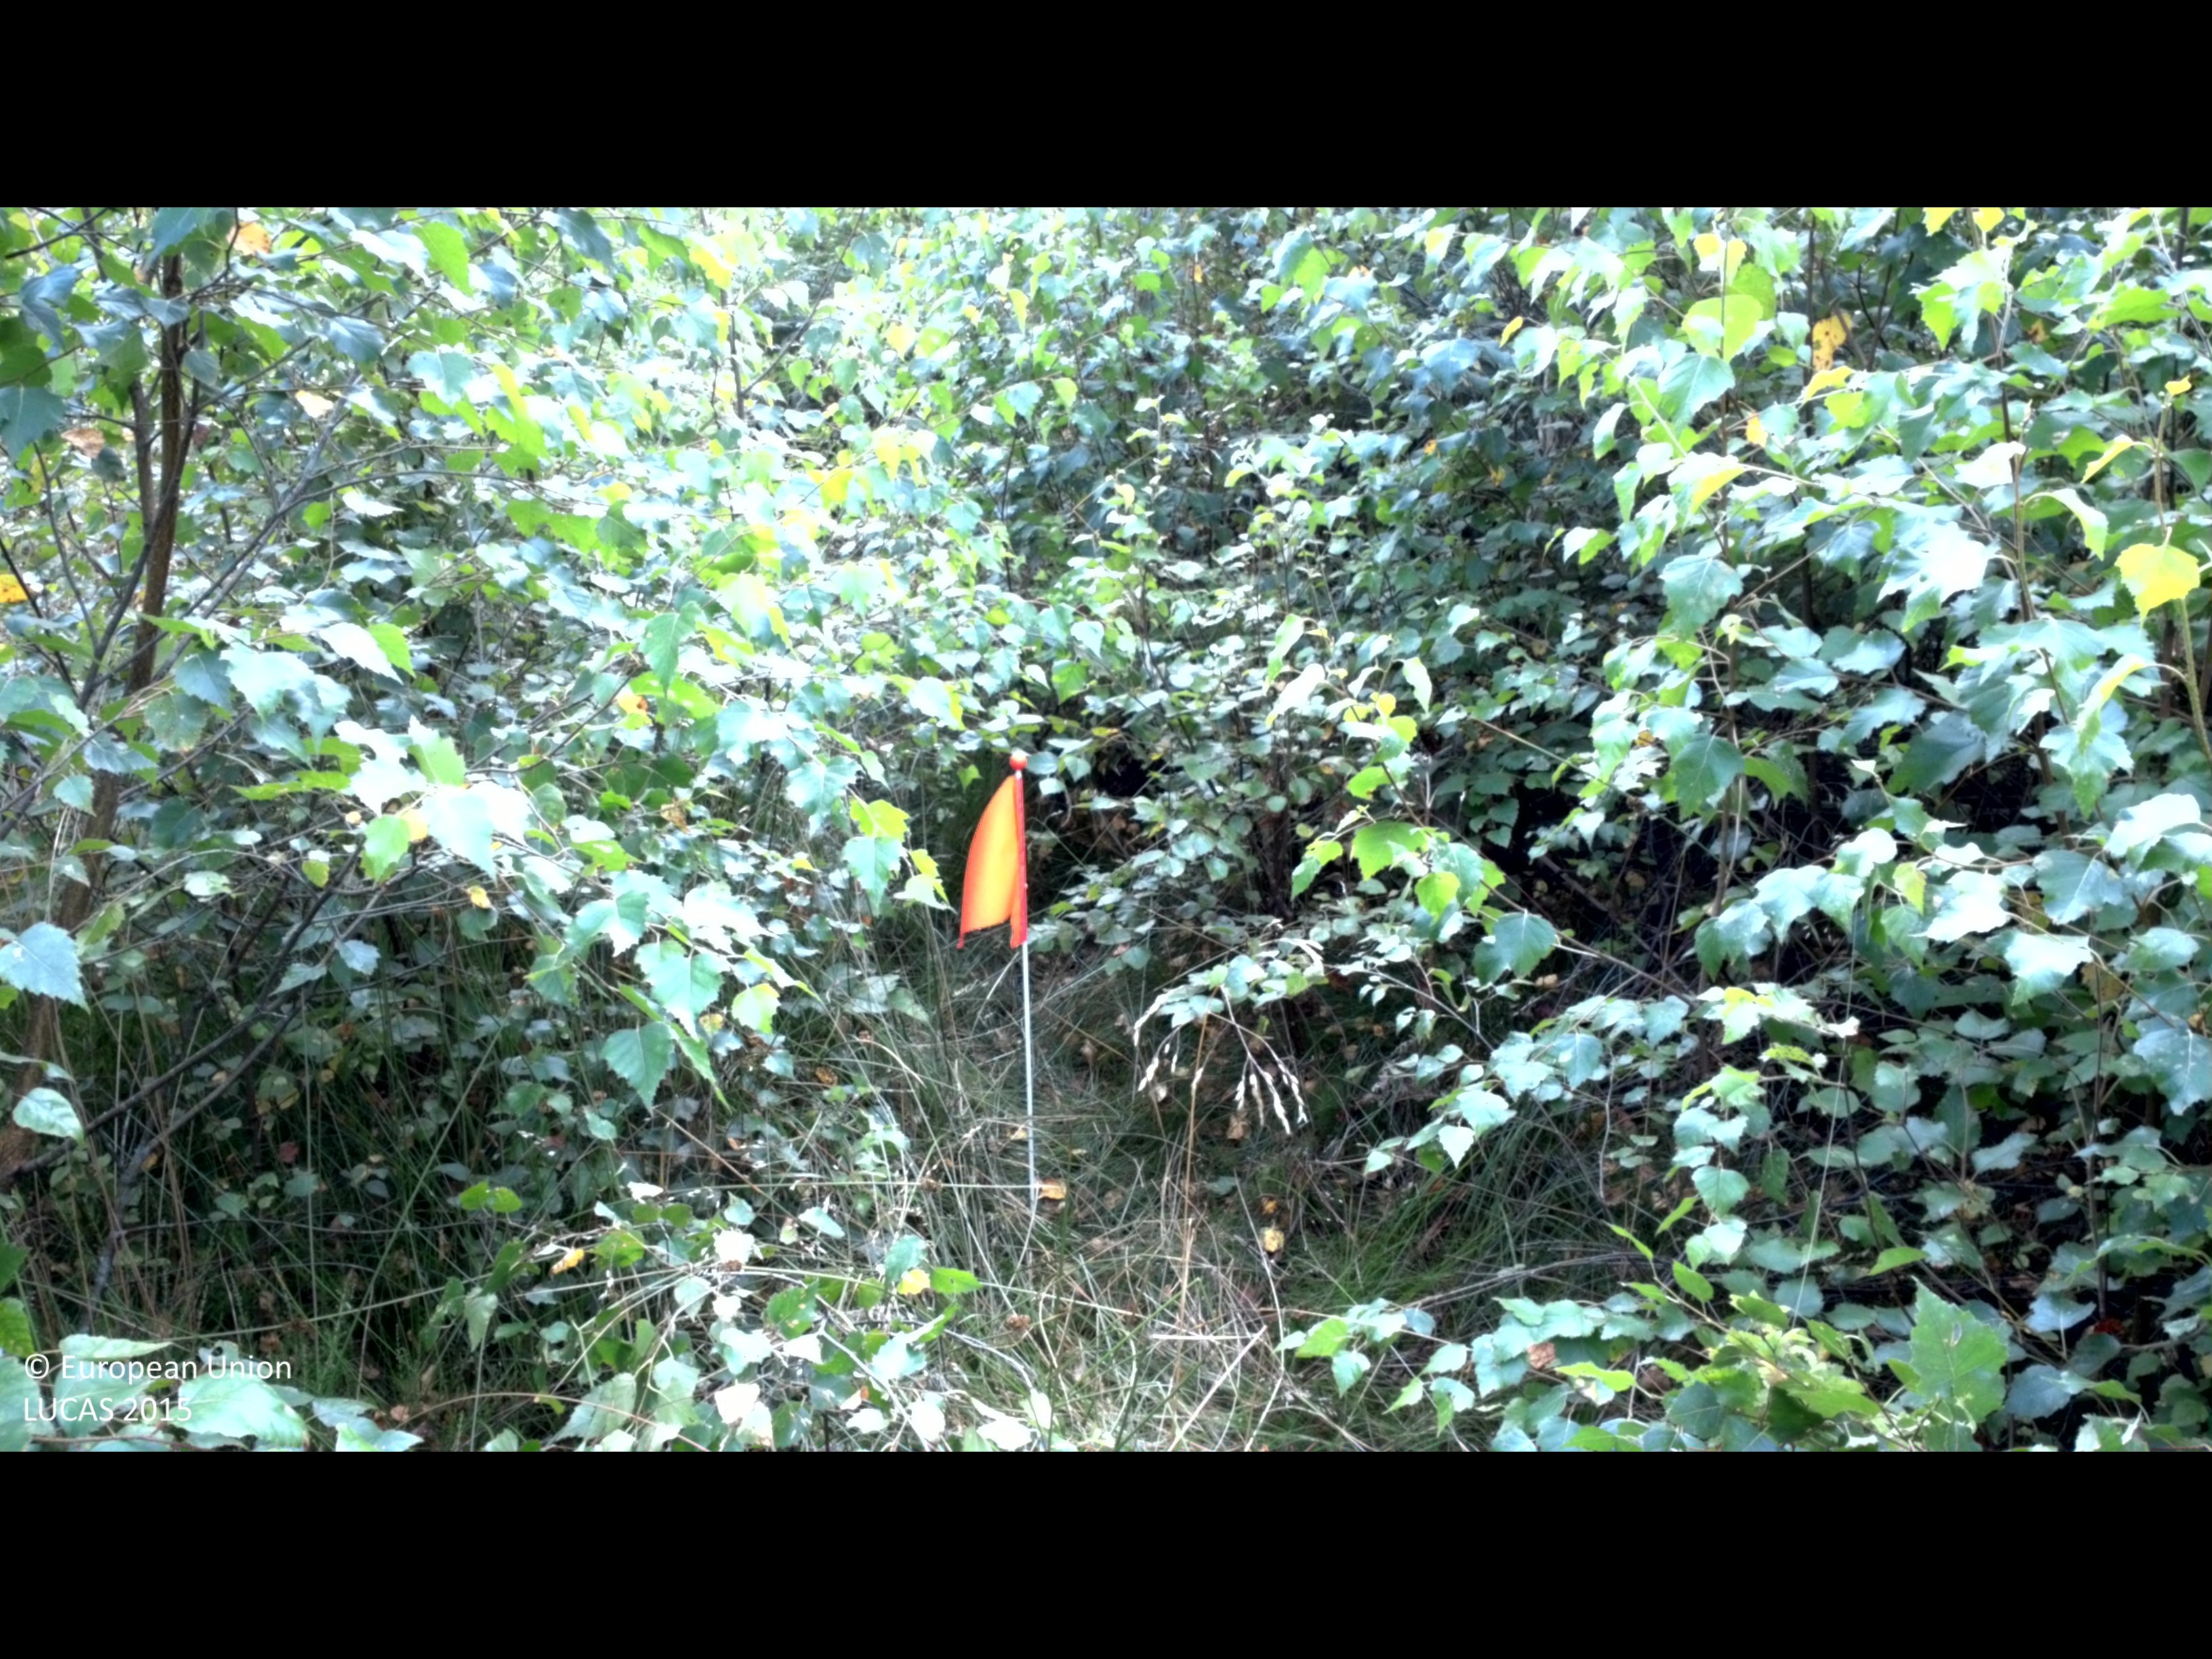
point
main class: Woodland
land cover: Spruce dominated mixed woodland
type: boreal forest
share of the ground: > 75 %
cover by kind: broadleaved forest trees 45 %, coniferous forest trees 30 %, herbaceous plants 20 %, shrubs 5 %
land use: Forestry
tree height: < 5 m
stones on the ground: < 10 %
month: August
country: SE
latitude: 56.8520
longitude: 13.7844
